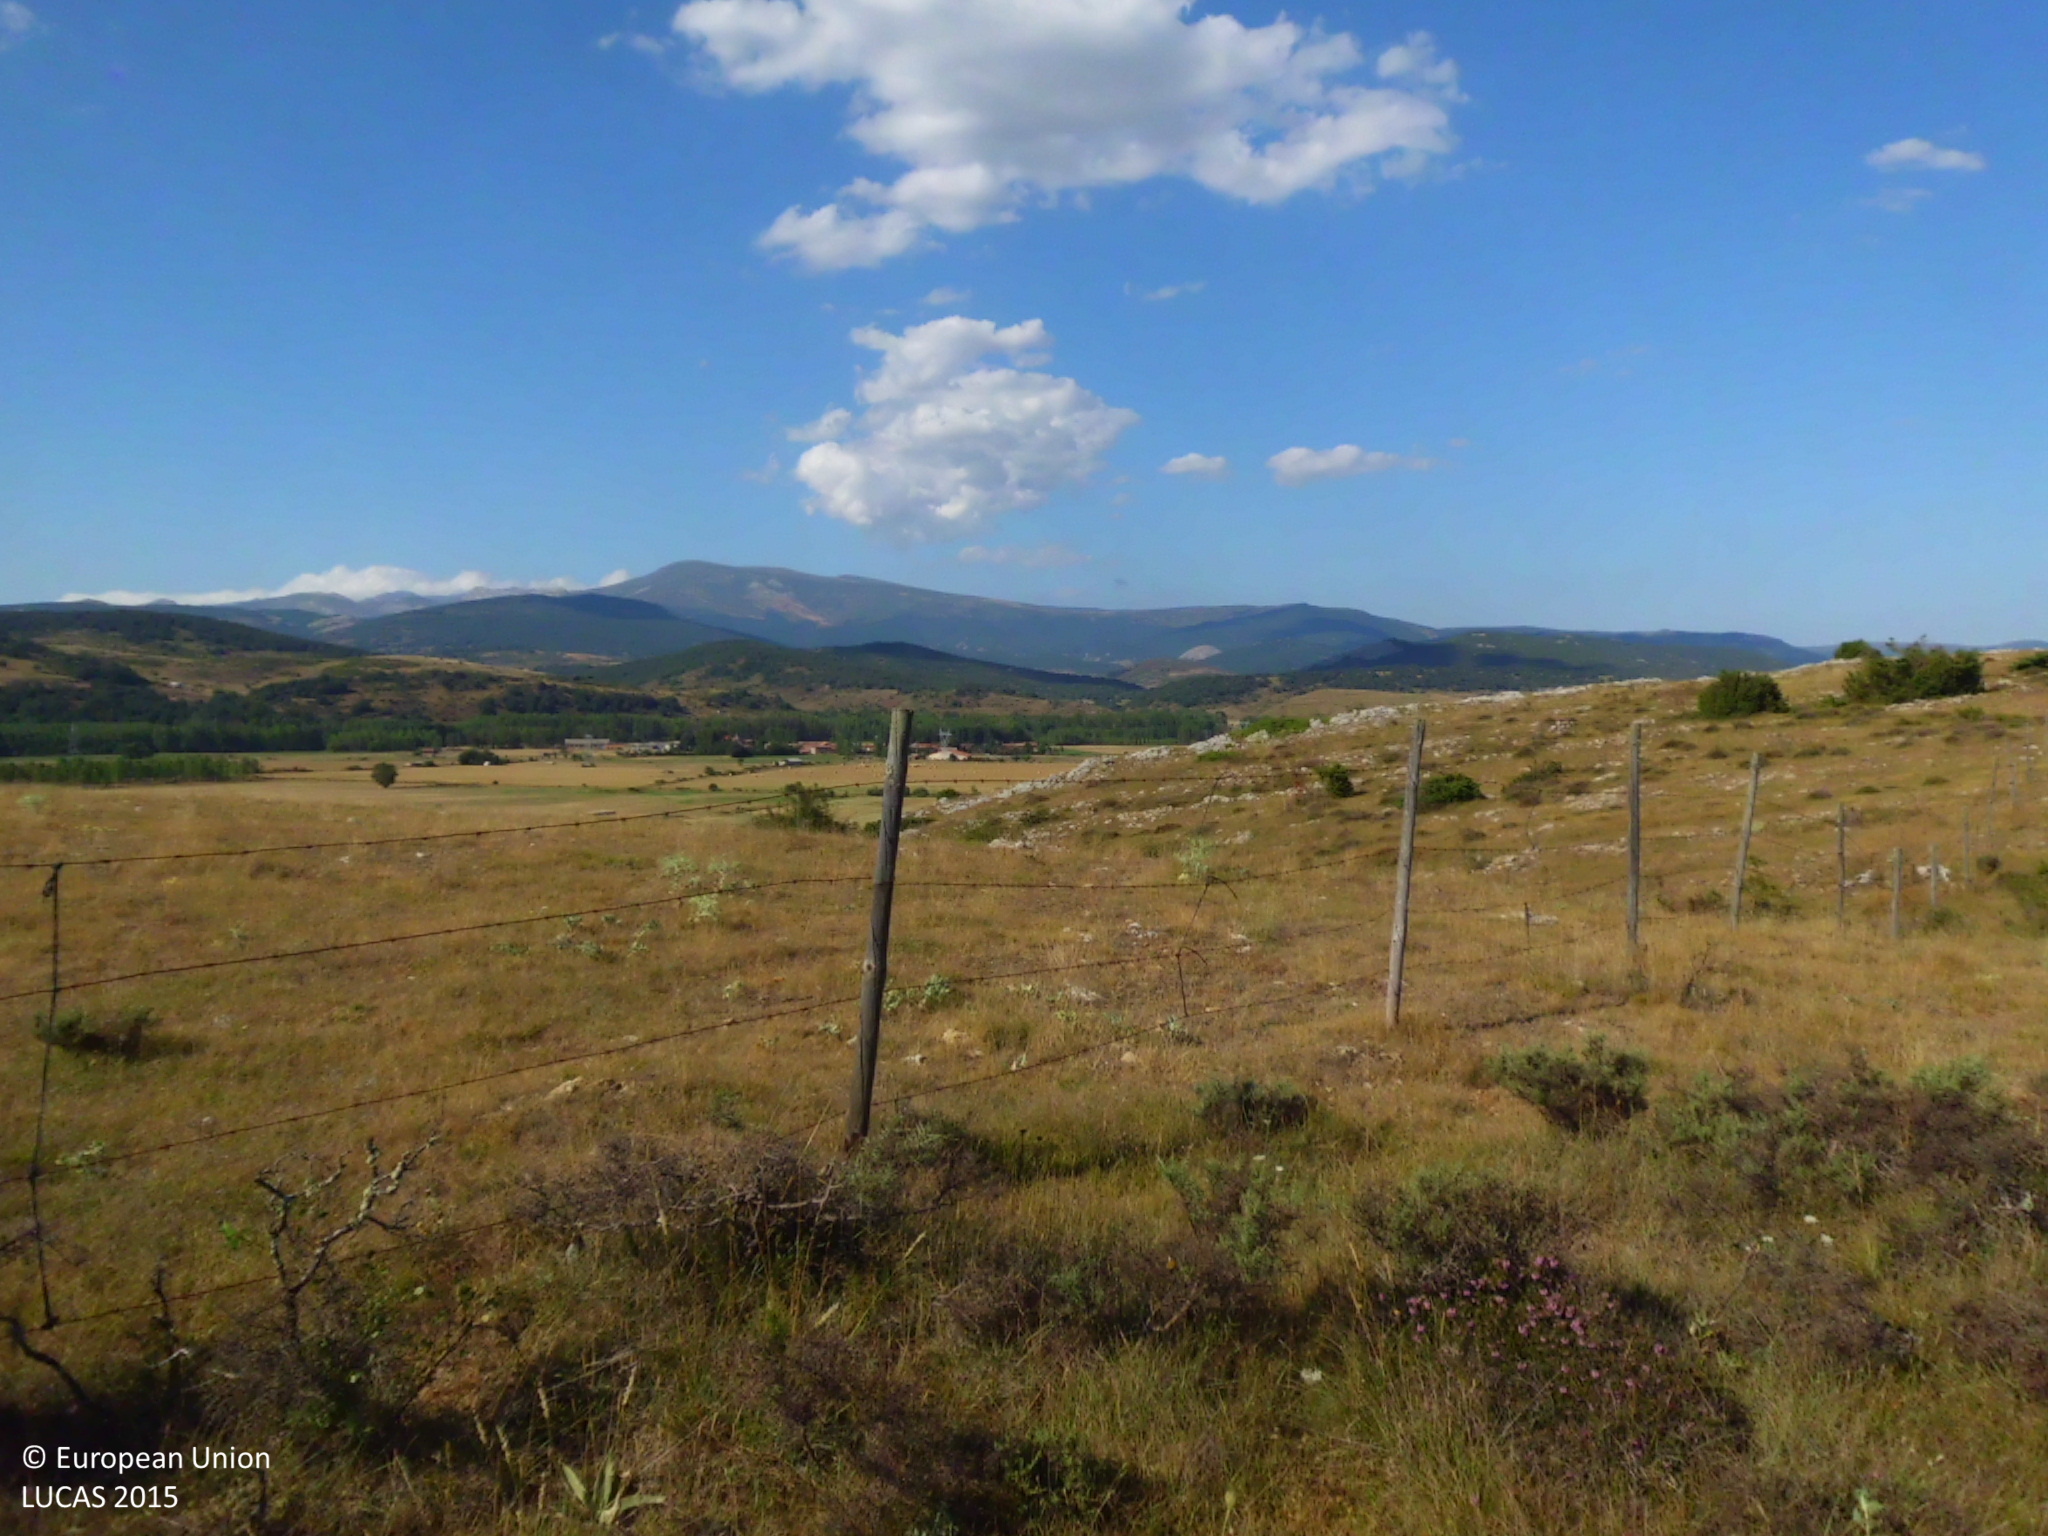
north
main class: Shrubland
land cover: Shrubland without tree cover
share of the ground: 25 - 50 %
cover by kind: herbaceous plants 75 %, shrubs 25 %
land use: Agriculture (excluding fallow land and kitchen gardens)
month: July
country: ES
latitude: 42.8415
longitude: -4.4301
